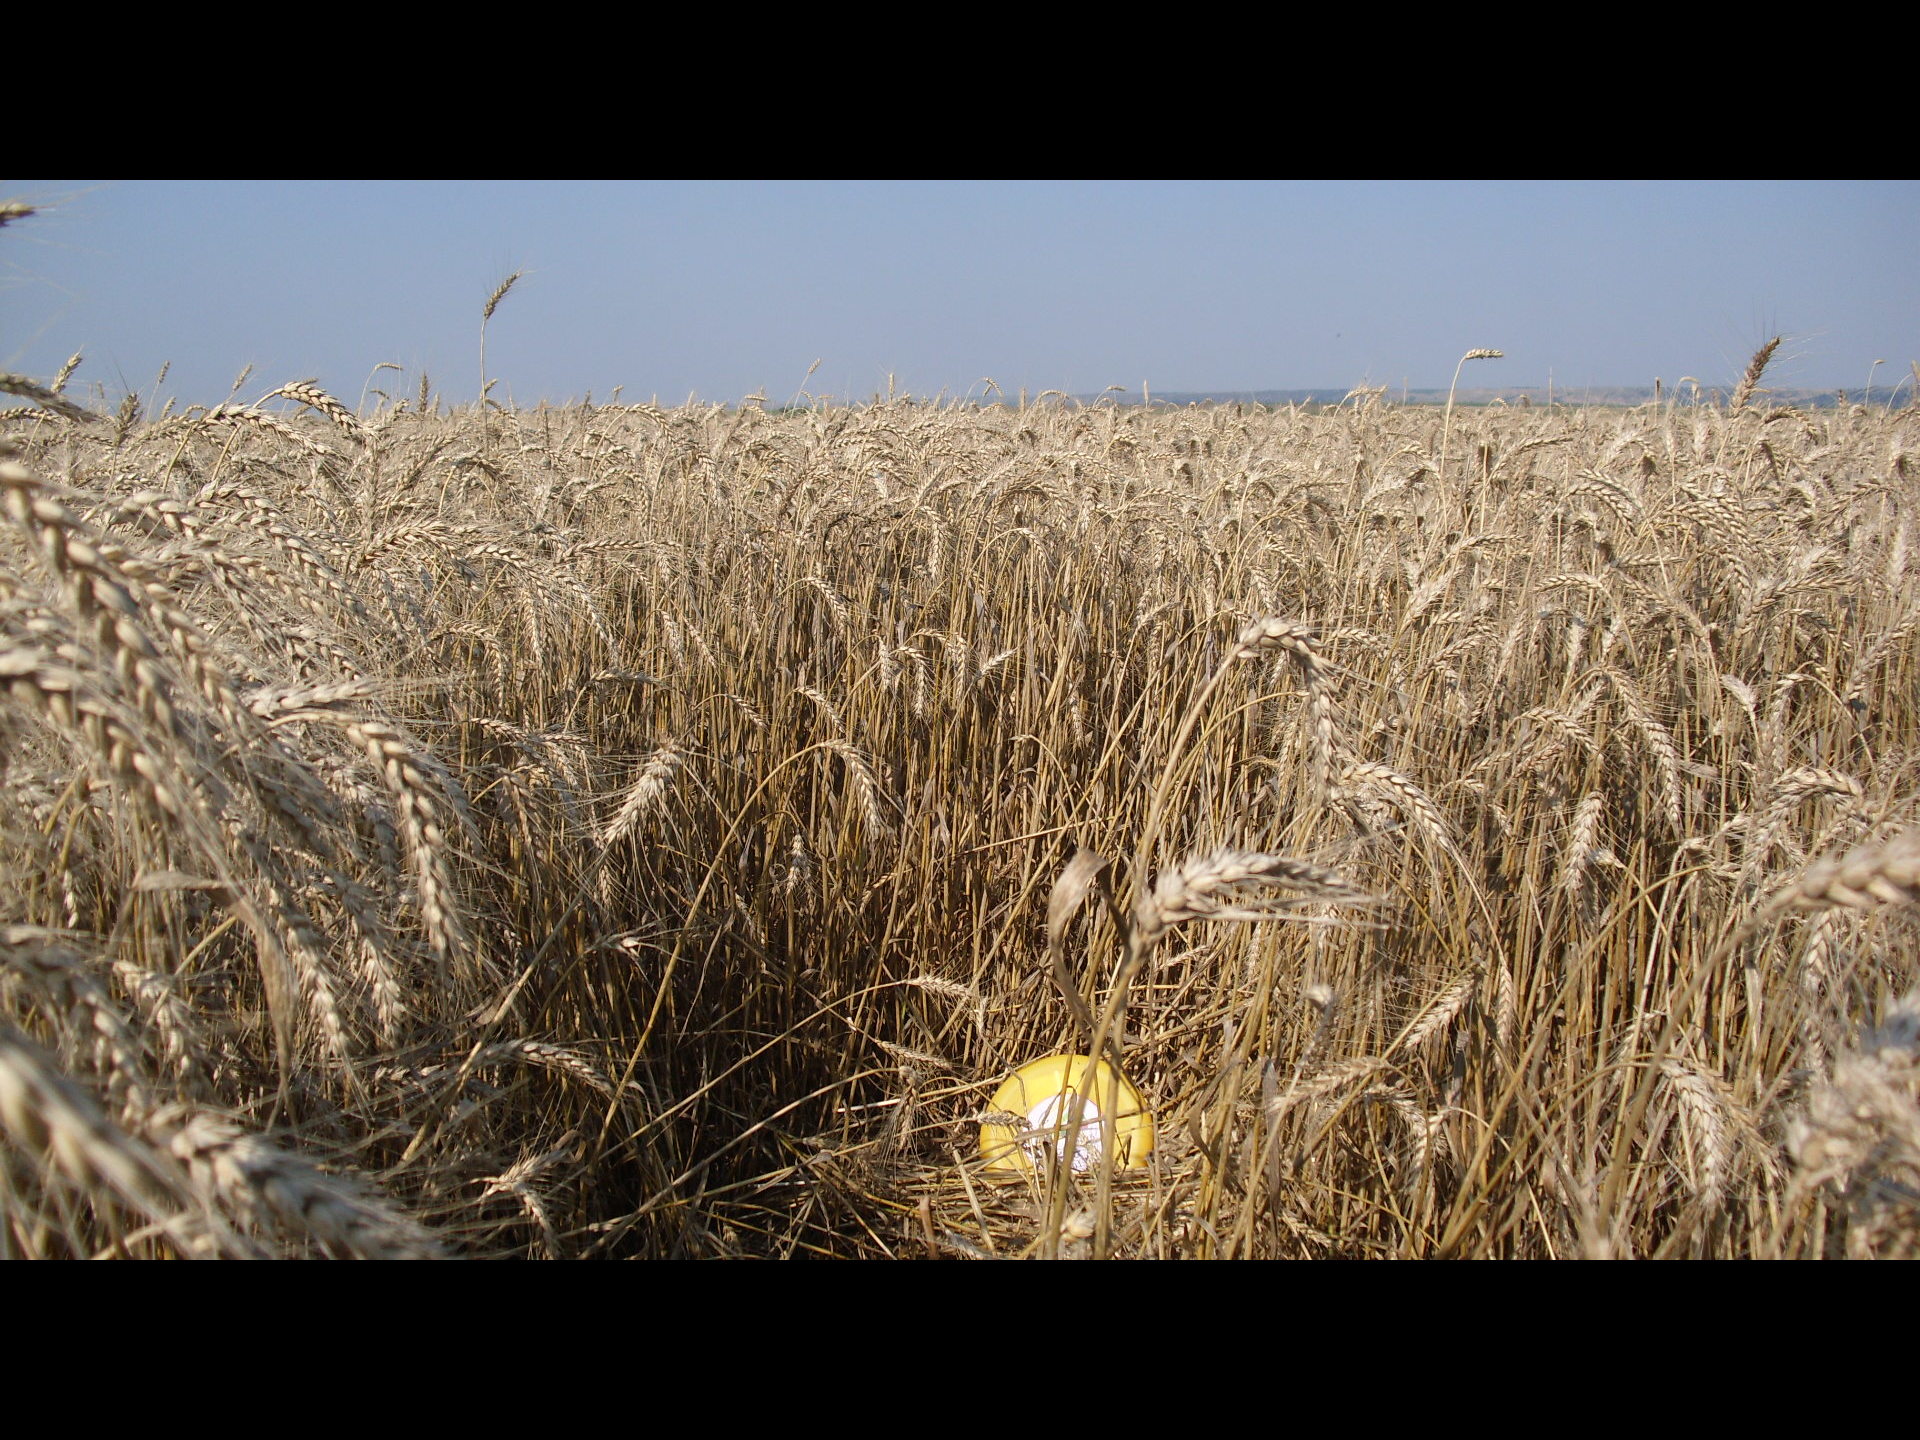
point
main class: Cropland
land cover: Common wheat
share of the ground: > 75 %
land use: Agriculture (excluding fallow land and kitchen gardens)
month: June
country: BG
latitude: 43.6661
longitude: 23.3507
